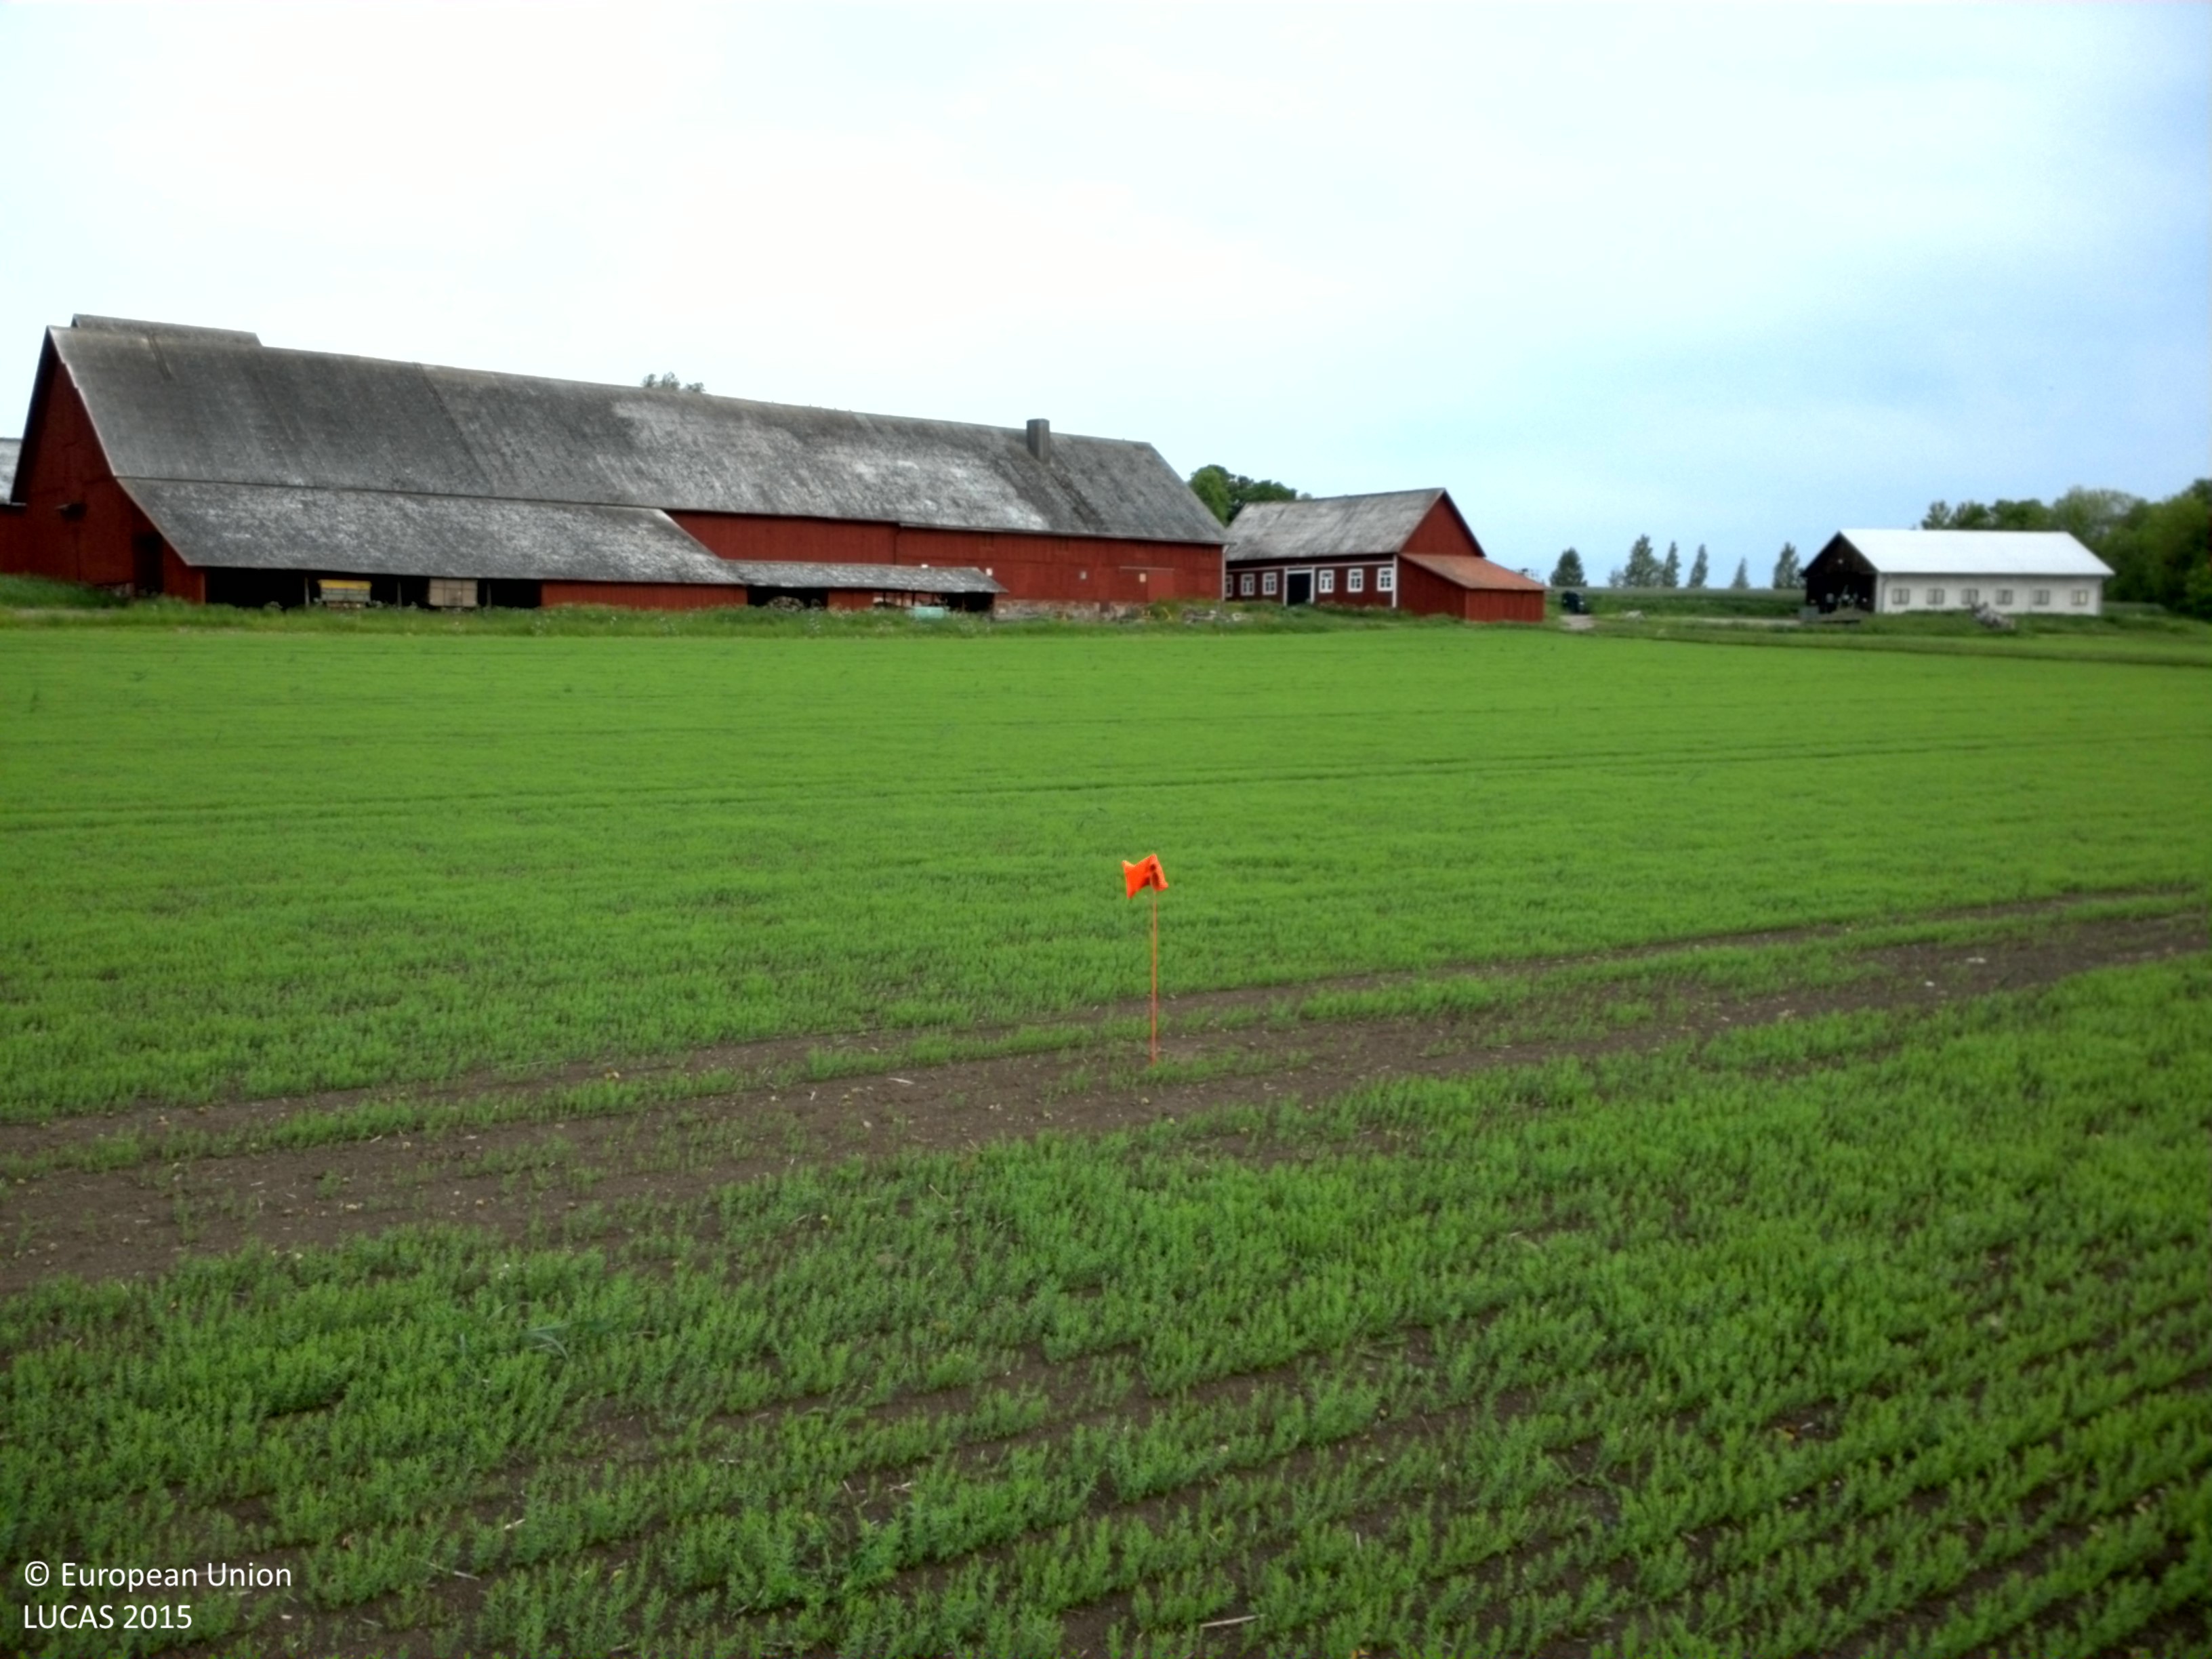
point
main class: Cropland
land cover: Other fibre and oleaginous crops
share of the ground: 10 - 25 %
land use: Agriculture (excluding fallow land and kitchen gardens)
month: June
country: SE
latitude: 58.4678
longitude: 15.4973
